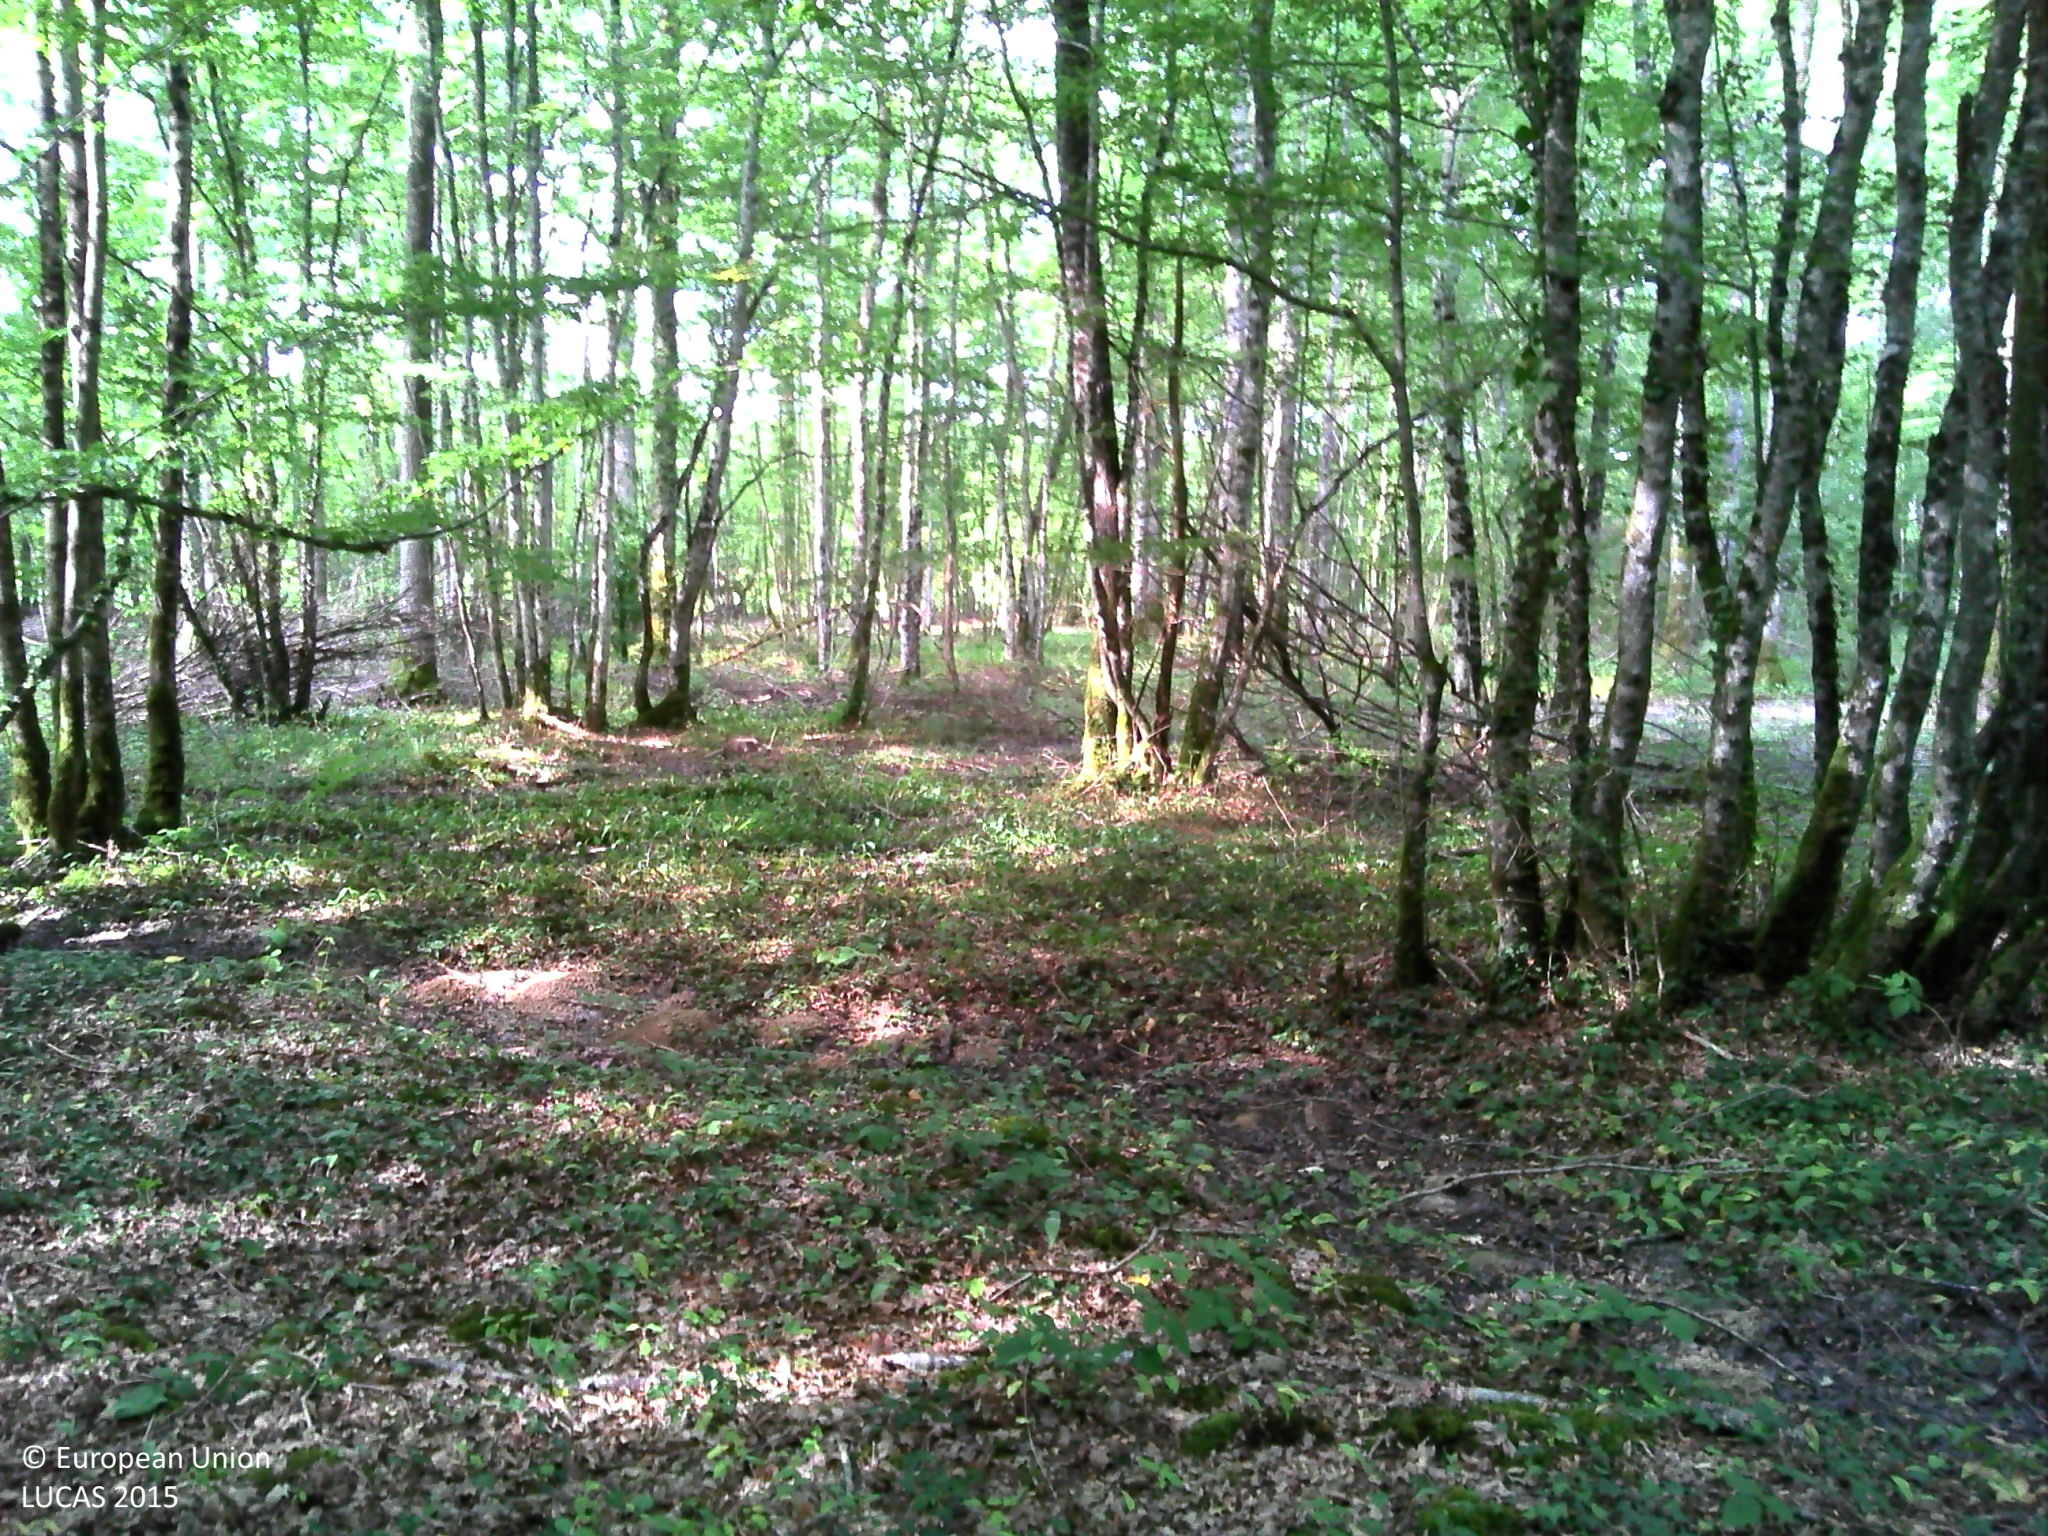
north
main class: Woodland
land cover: Broadleaved woodland
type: mesophytic deciduous forest
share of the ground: > 75 %
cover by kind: broadleaved forest trees 90 %, herbaceous plants 5 %, lichens and mosses 5 %
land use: Forestry
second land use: Amenities, museums, leisure
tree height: > 5 m
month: August
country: FR
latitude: 47.7168
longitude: 3.0757
